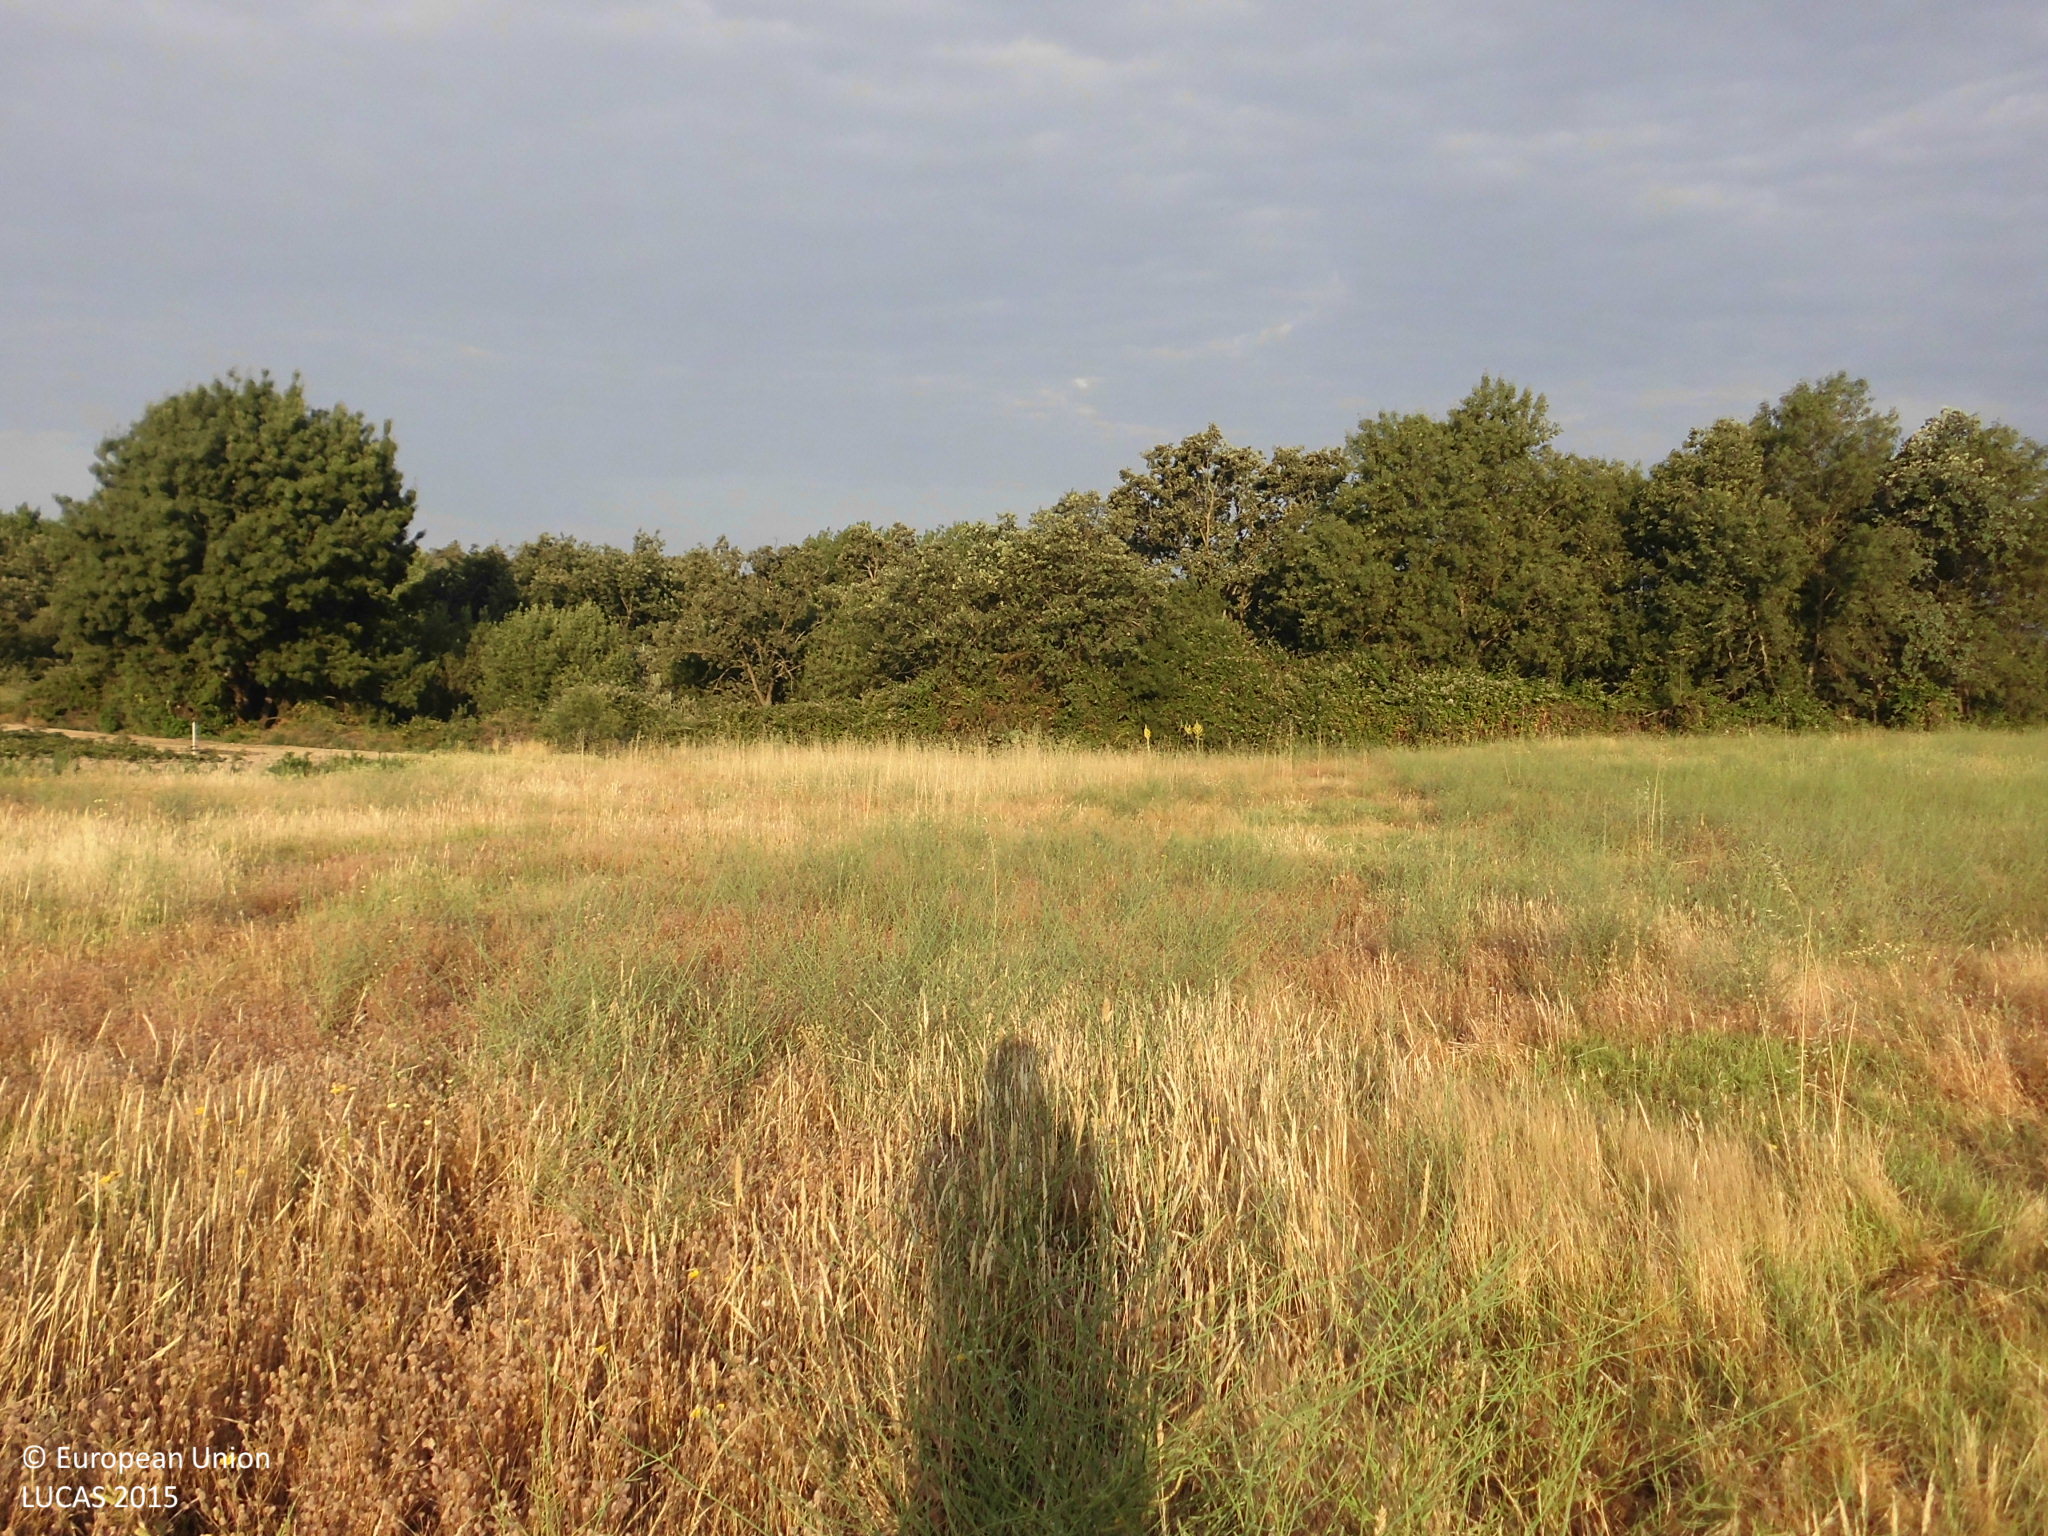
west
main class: Grassland
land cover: Spontaneously vegetated surfaces
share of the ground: > 75 %
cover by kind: herbaceous plants 100 %
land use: Fallow land
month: June
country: ES
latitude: 40.0639
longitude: -5.4538
